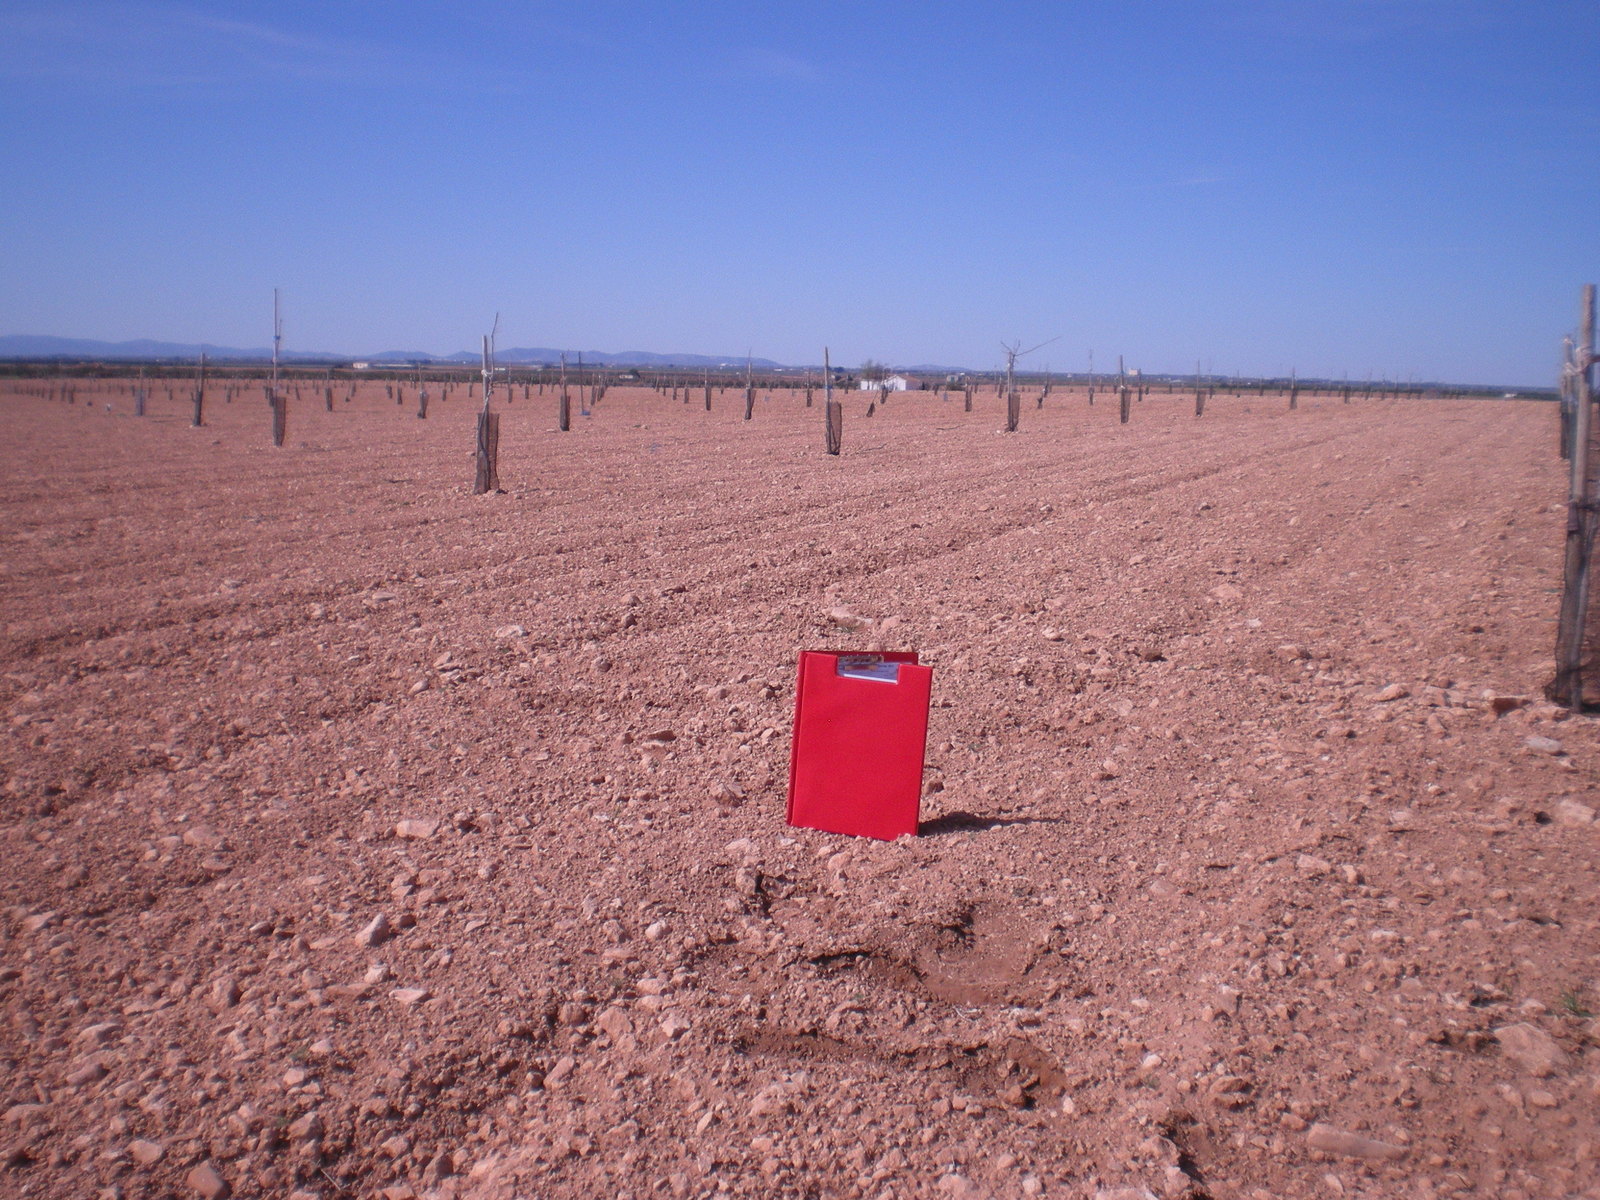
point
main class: Cropland
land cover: Nuts trees
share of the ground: < 10 %
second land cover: Other bare soil
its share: > 75 %
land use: Agriculture (excluding fallow land and kitchen gardens)
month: March
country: ES
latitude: 39.0600
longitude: -3.1991
